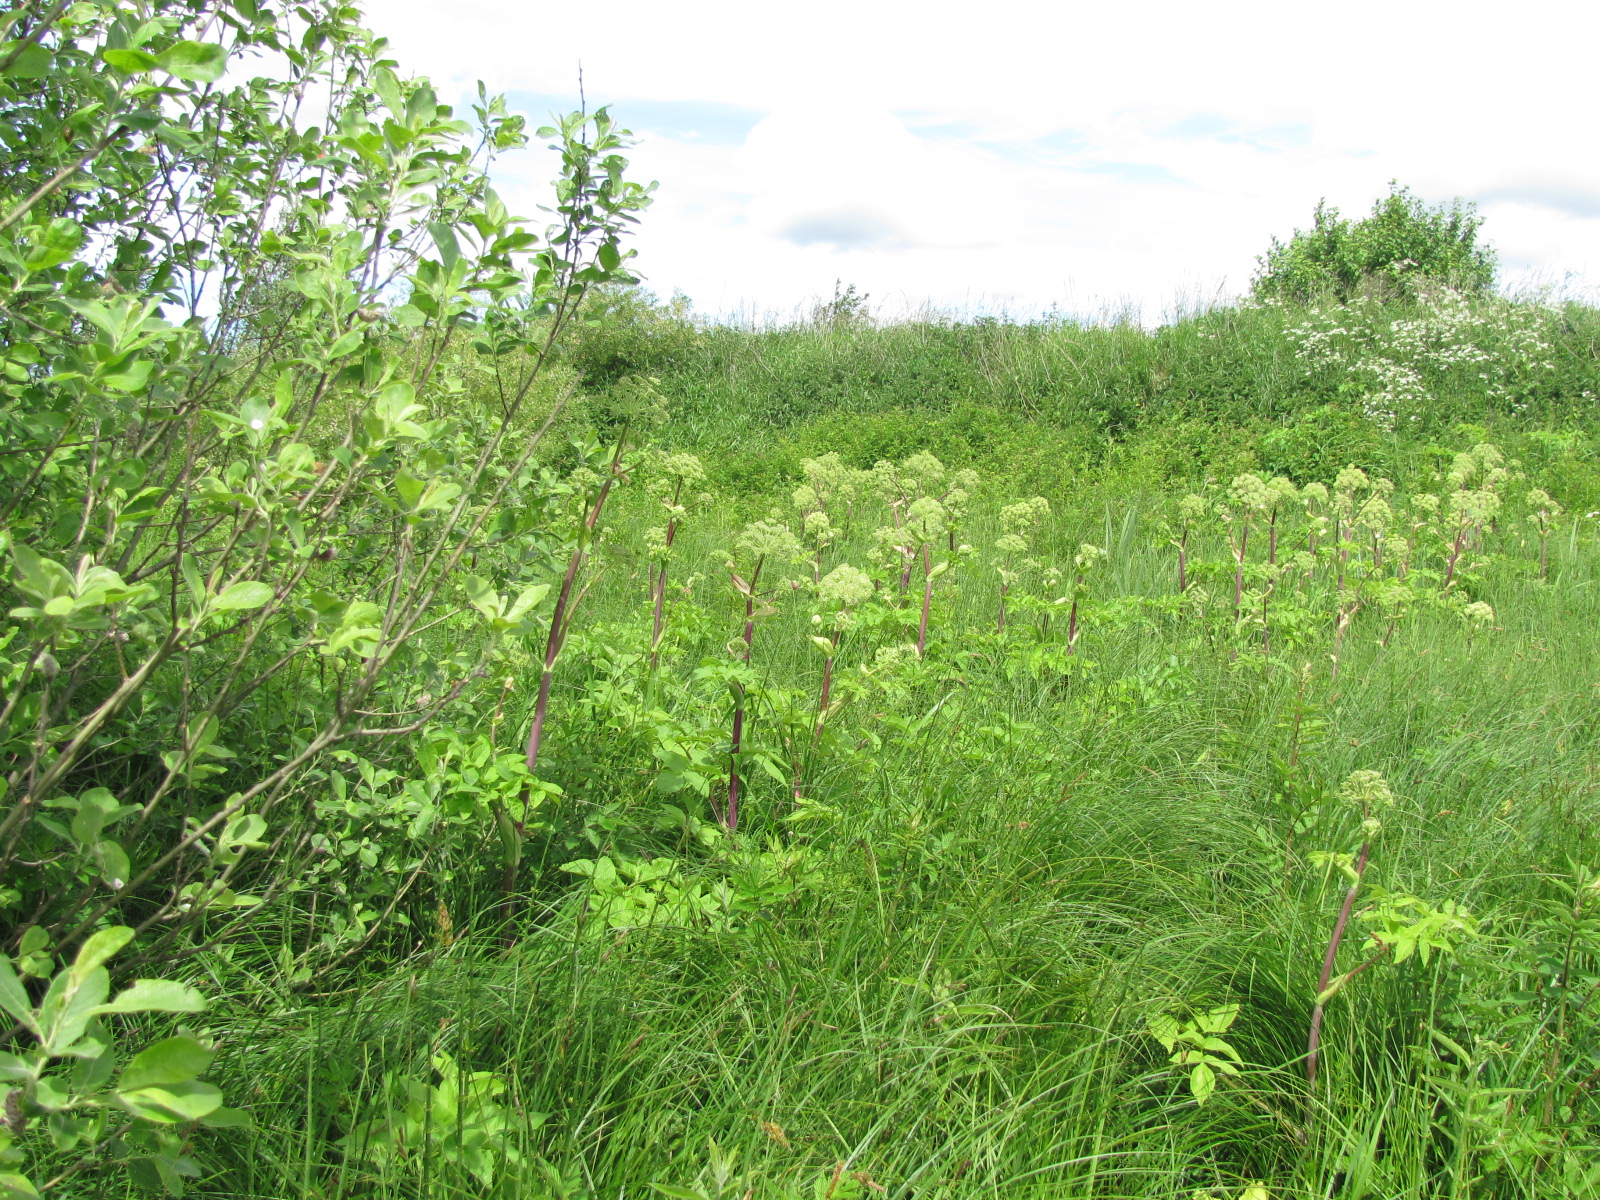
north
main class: Grassland
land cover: Grassland without tree/shrub cover
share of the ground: > 75 %
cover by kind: herbaceous plants 100 %
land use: Semi-natural and natural areas not in use
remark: Temporary flooded
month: June
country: LV
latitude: 56.6440
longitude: 23.7946
